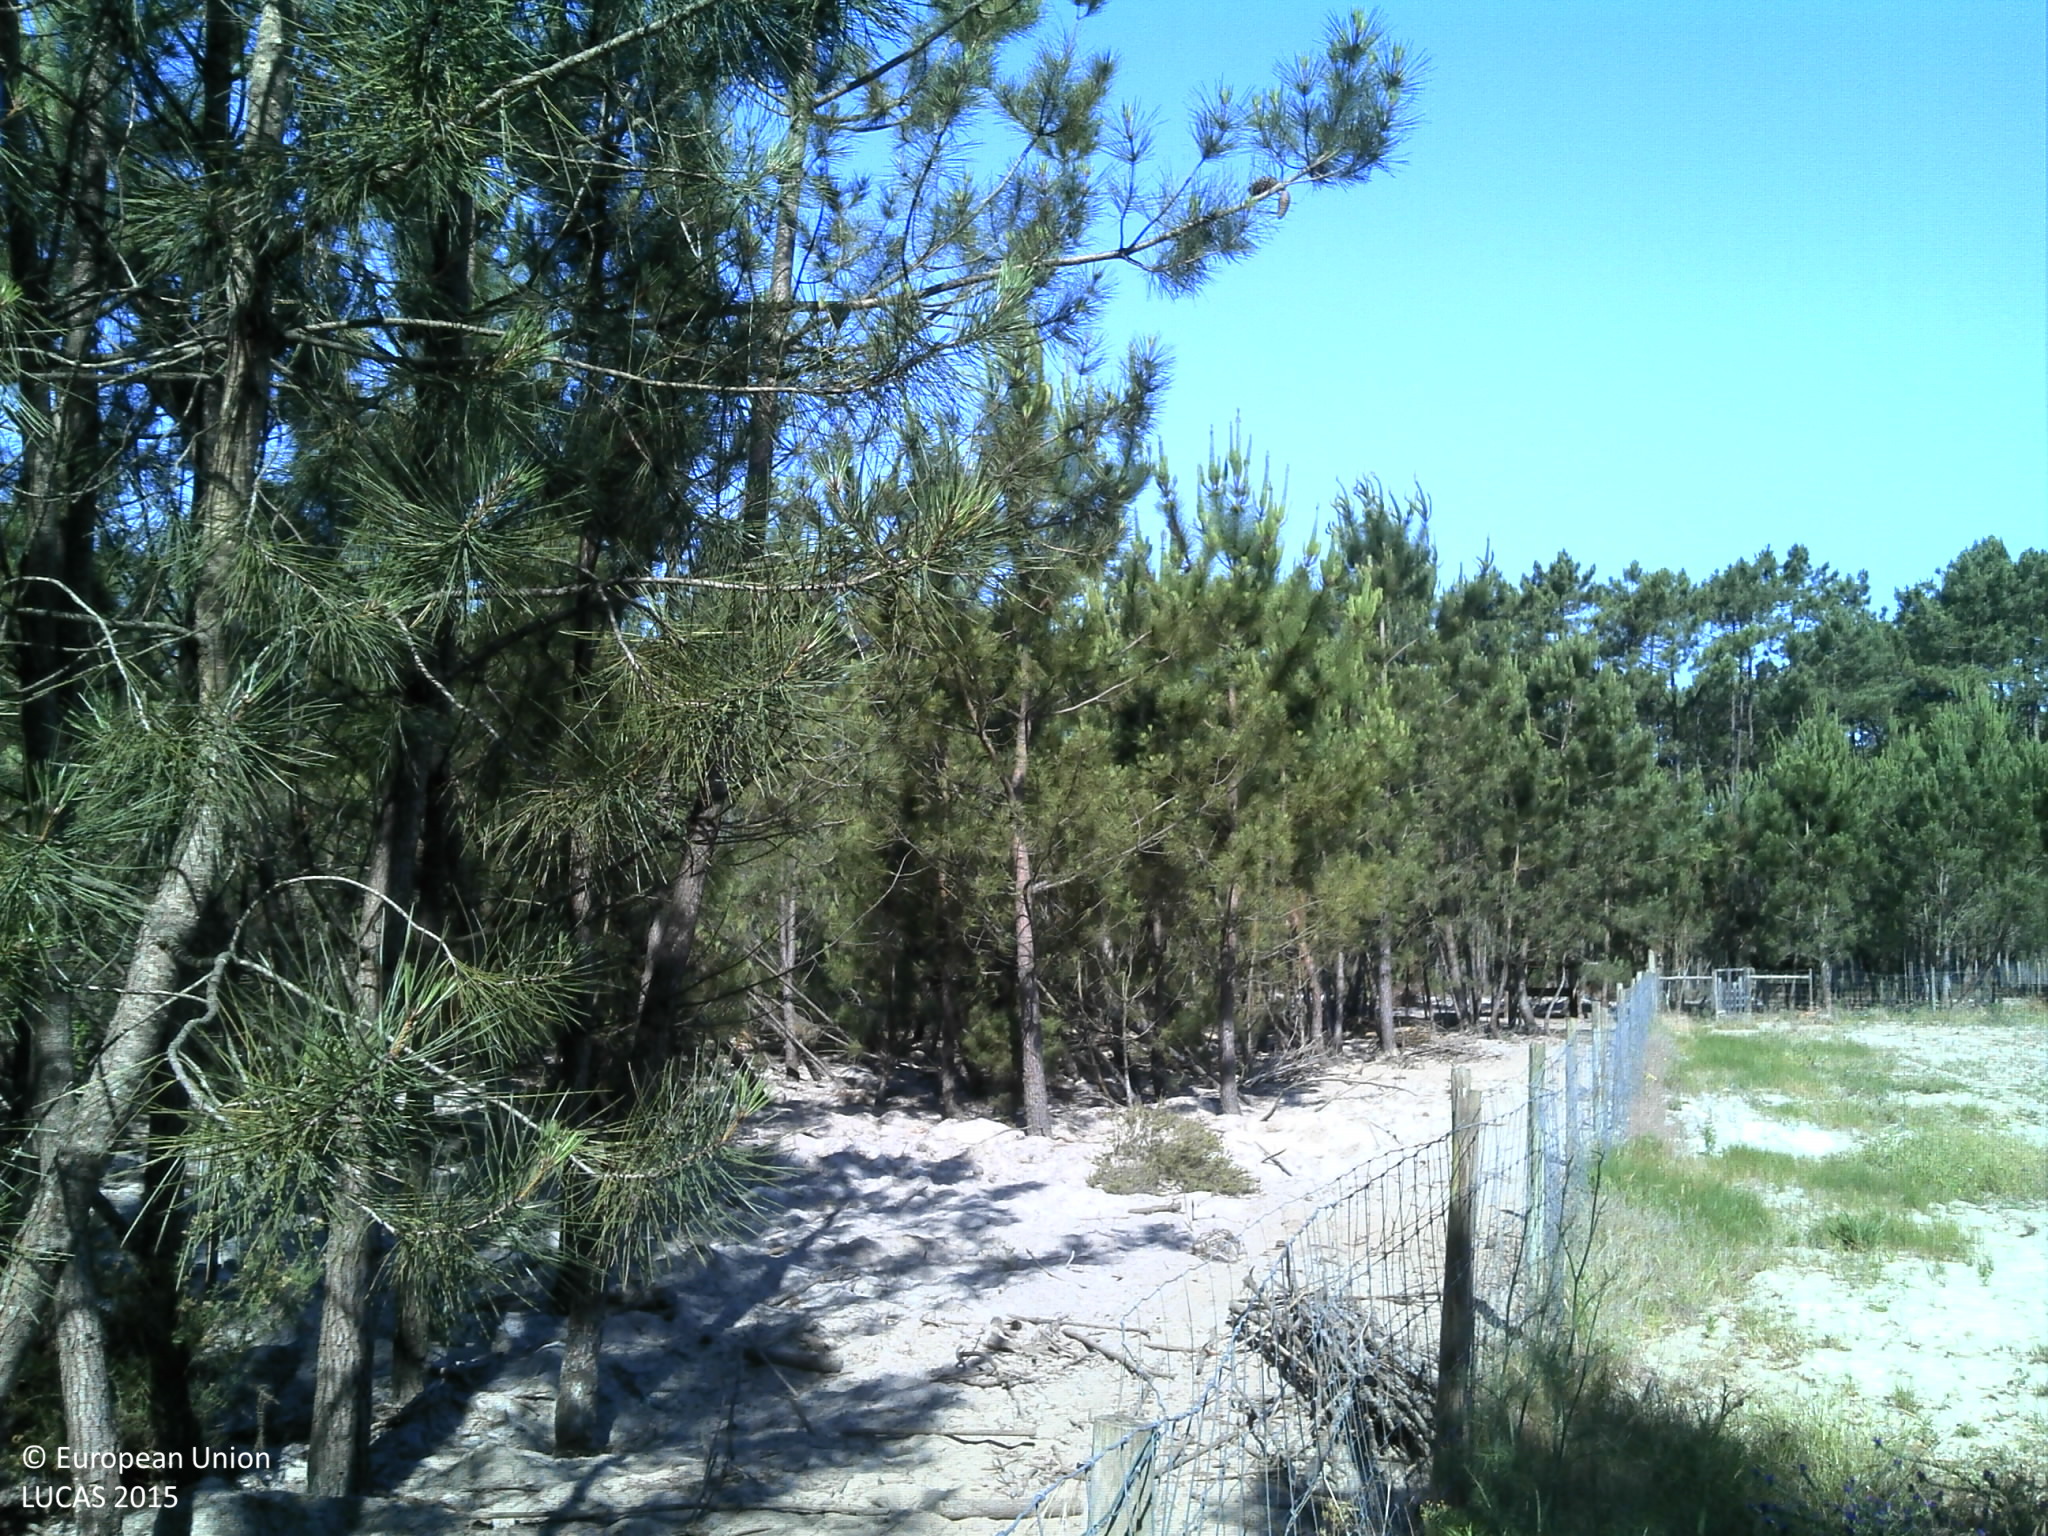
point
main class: Woodland
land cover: Pine dominated coniferous woodland
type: coniferous forest of the mediterranean region
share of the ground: 50 - 75 %
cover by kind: coniferous forest trees 60 %, unconsolidated bare surface 35 %, herbaceous plants 5 %
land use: Forestry
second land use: Agriculture (excluding fallow land and kitchen gardens)
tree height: > 5 m
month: June
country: PT
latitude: 40.3556
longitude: -8.7098
